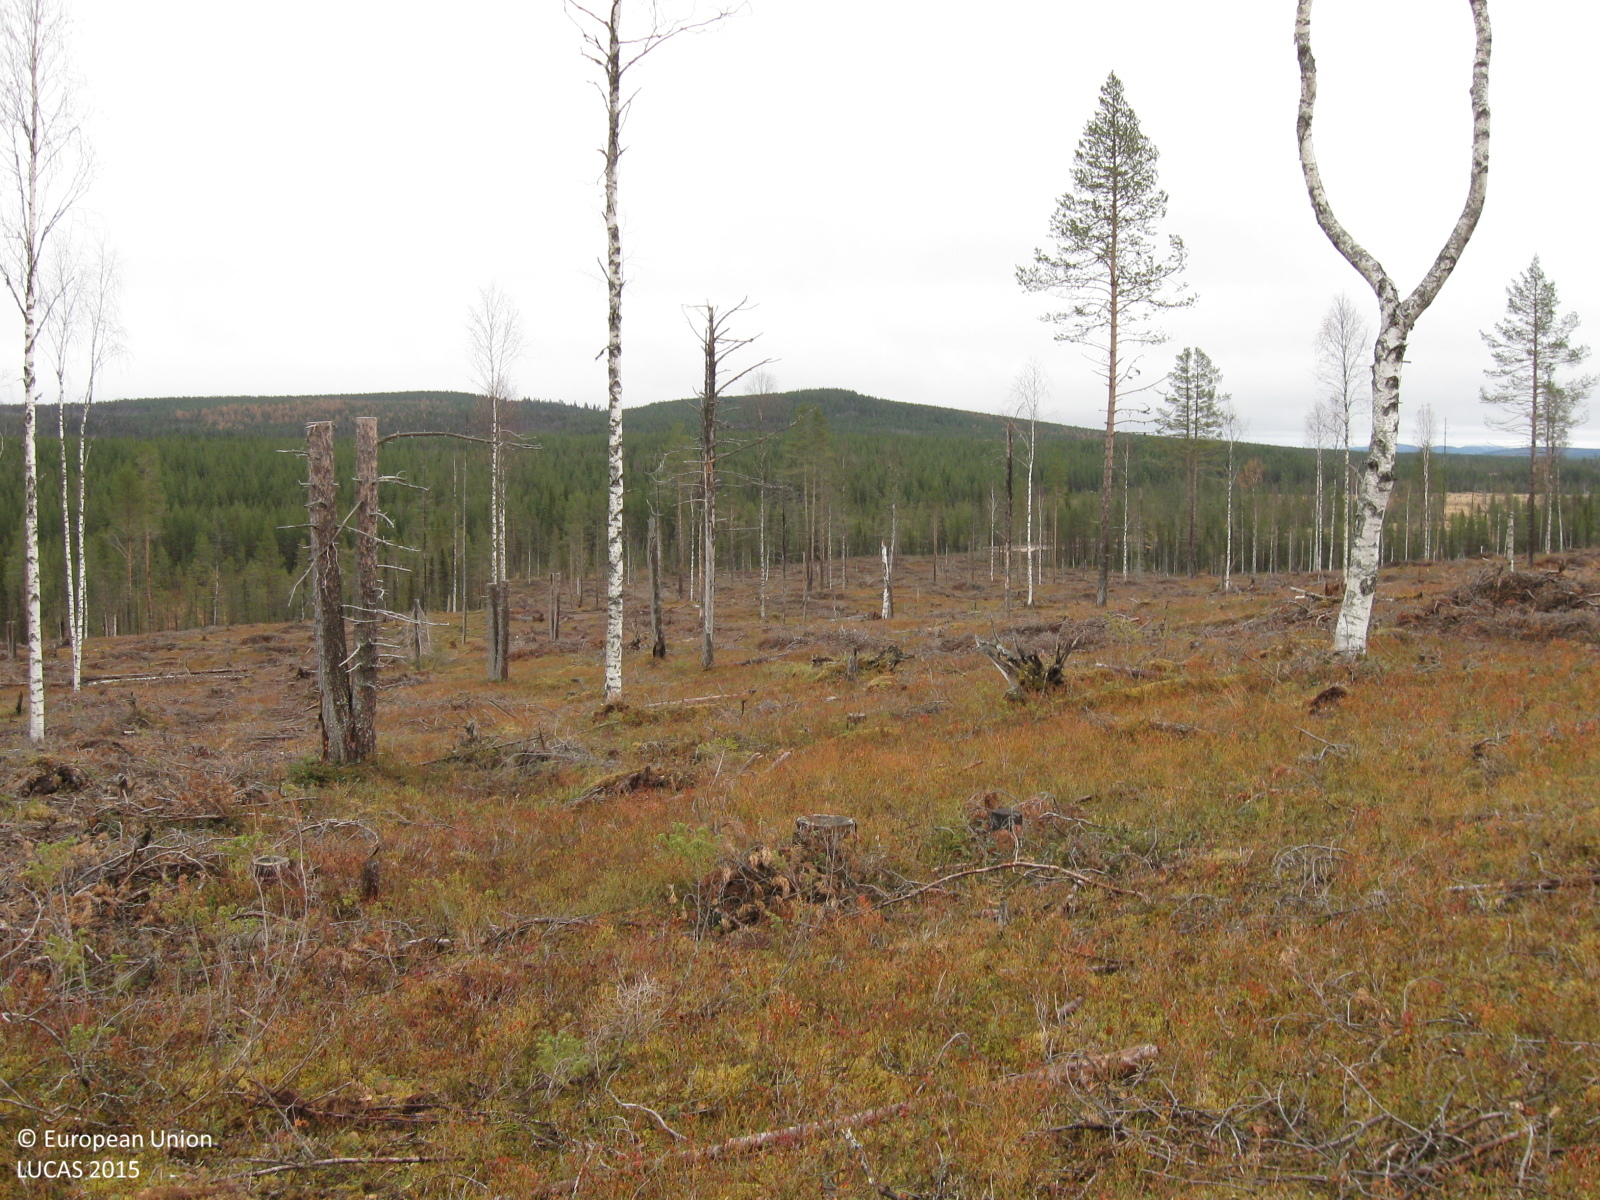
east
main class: Shrubland
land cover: Shrubland with sparse tree cover
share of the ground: 50 - 75 %
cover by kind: shrubs 65 %, lichens and mosses 15 %, herbaceous plants 10 %, coniferous forest trees 5 %
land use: Forestry
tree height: < 5 m
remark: Clear cut
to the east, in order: Shrubland with sparse tree cover
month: October
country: SE
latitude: 66.7165
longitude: 21.6364
